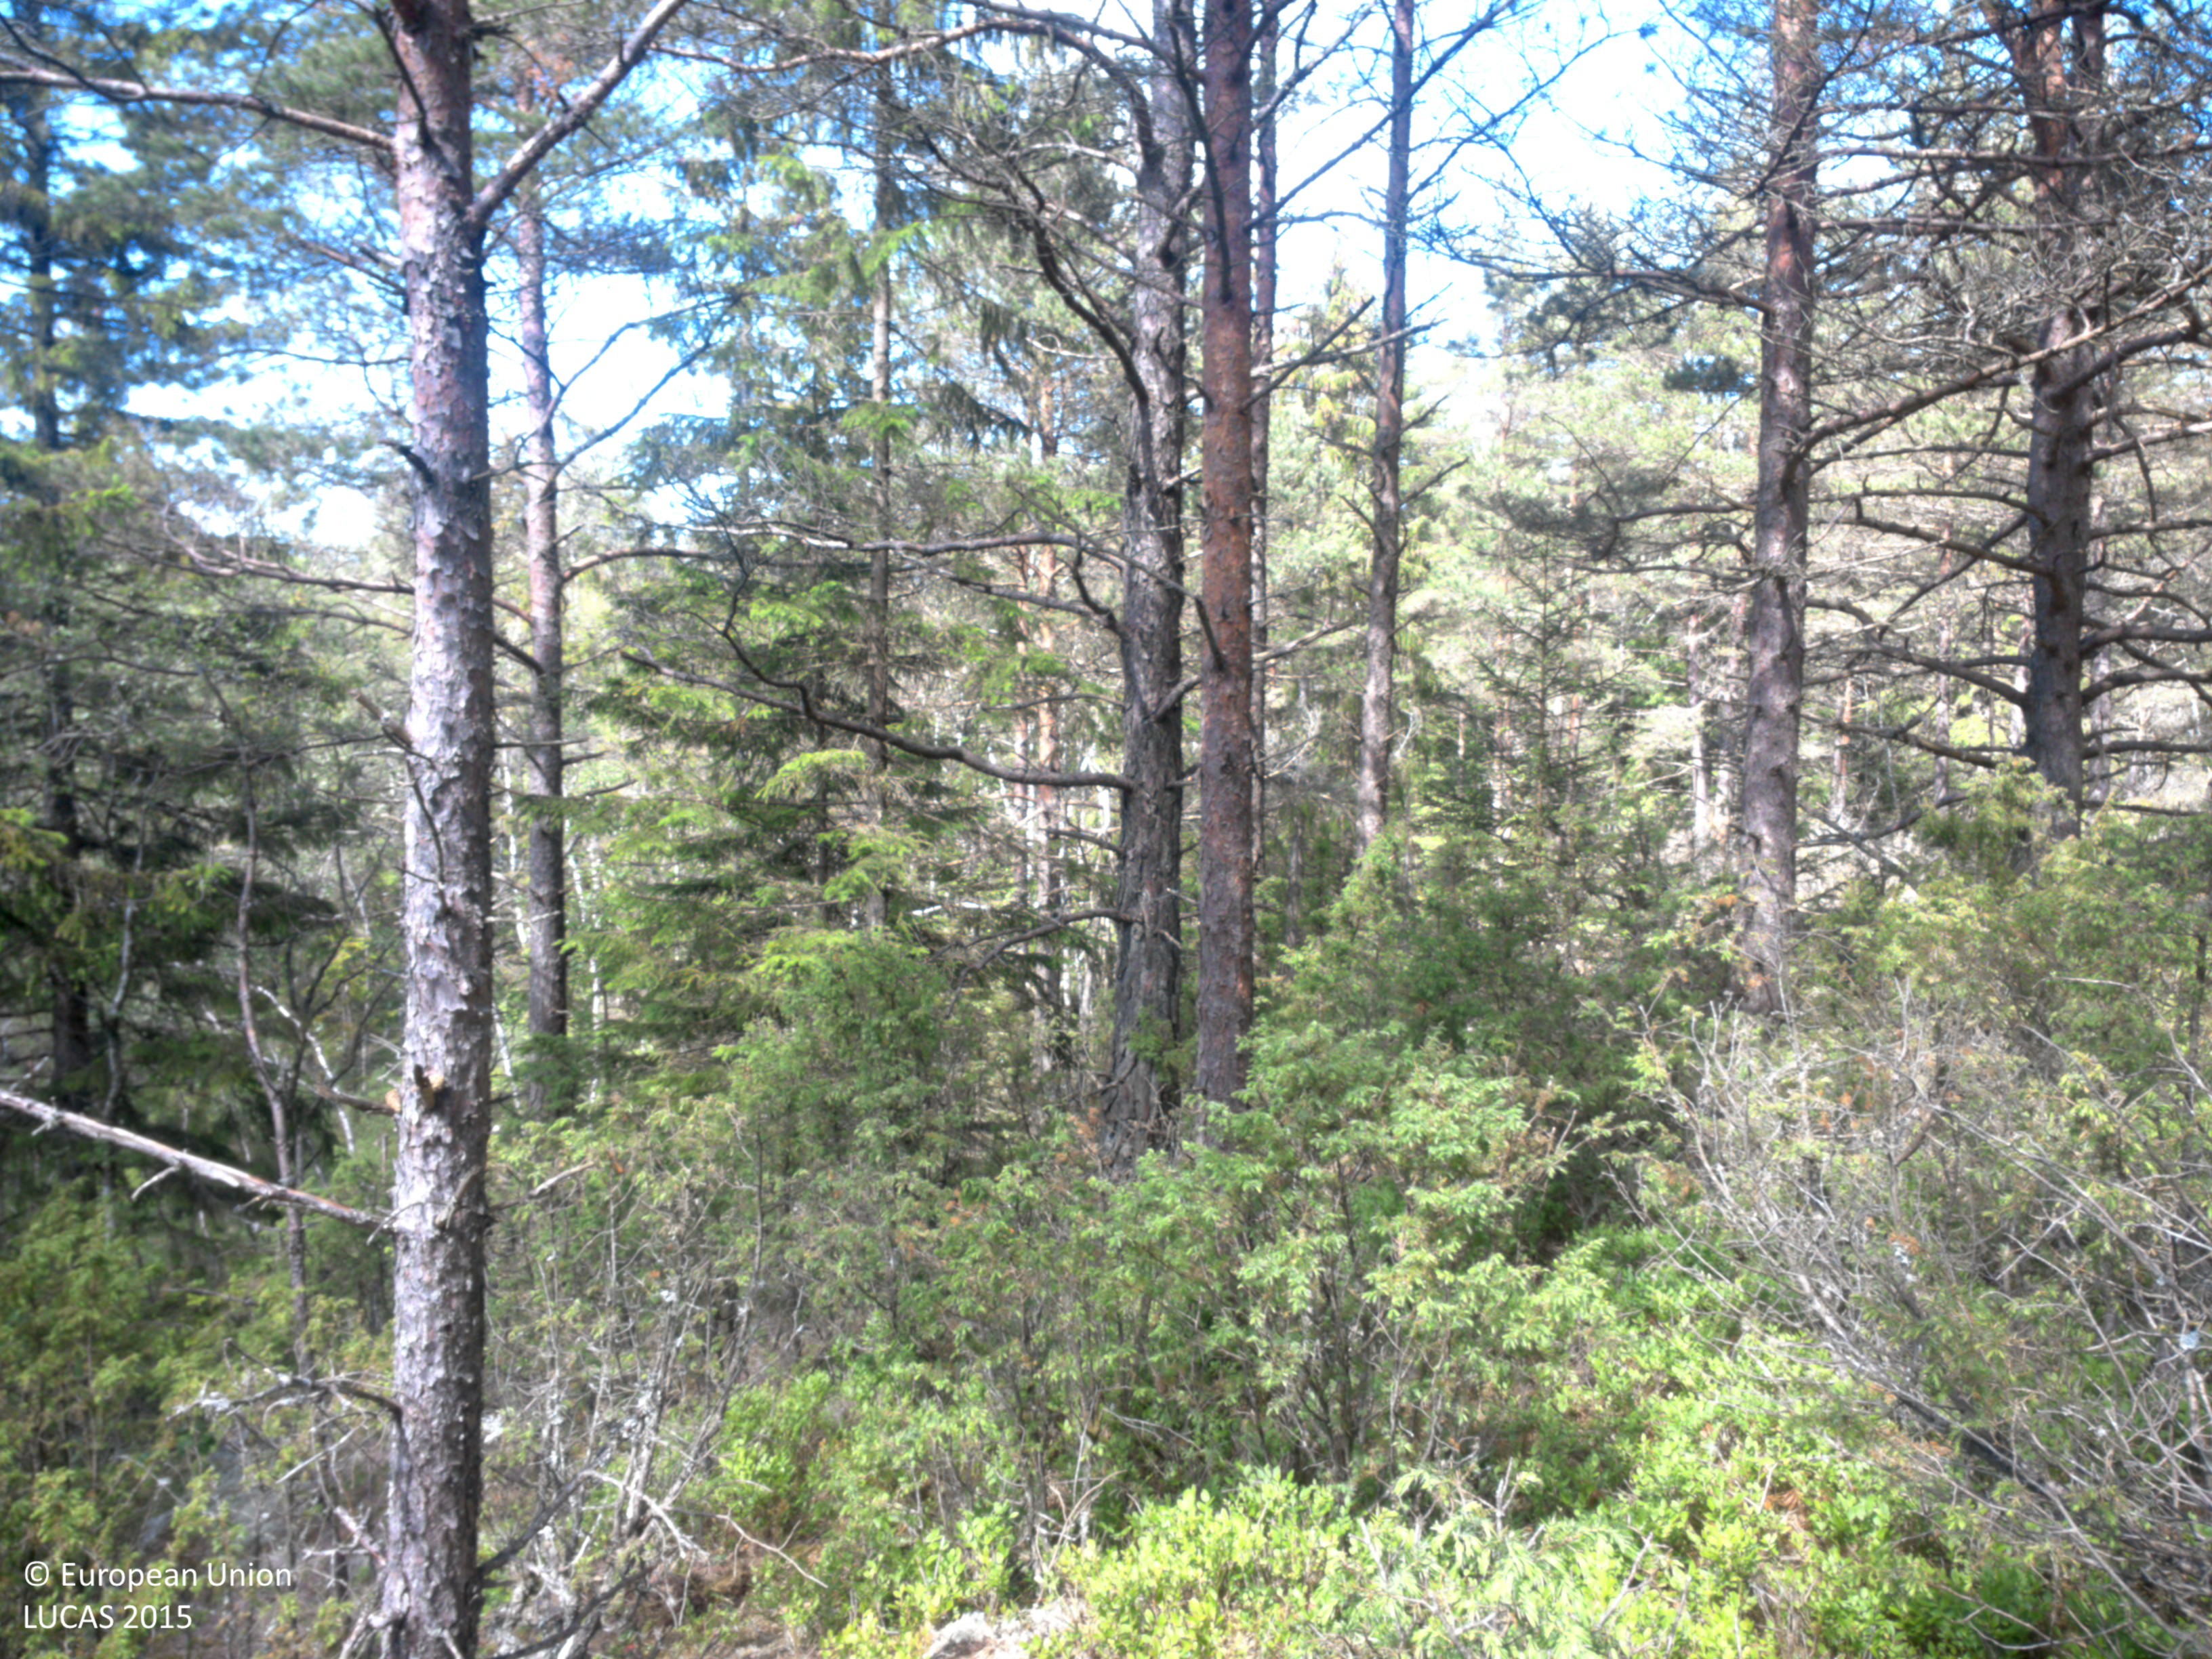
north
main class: Woodland
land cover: Pine dominated coniferous woodland
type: boreal forest
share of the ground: 50 - 75 %
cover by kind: coniferous forest trees 50 %, lichens and mosses 40 %, shrubs 10 %
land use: Forestry
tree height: > 5 m
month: June
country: SE
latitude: 58.6066
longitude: 11.5285
